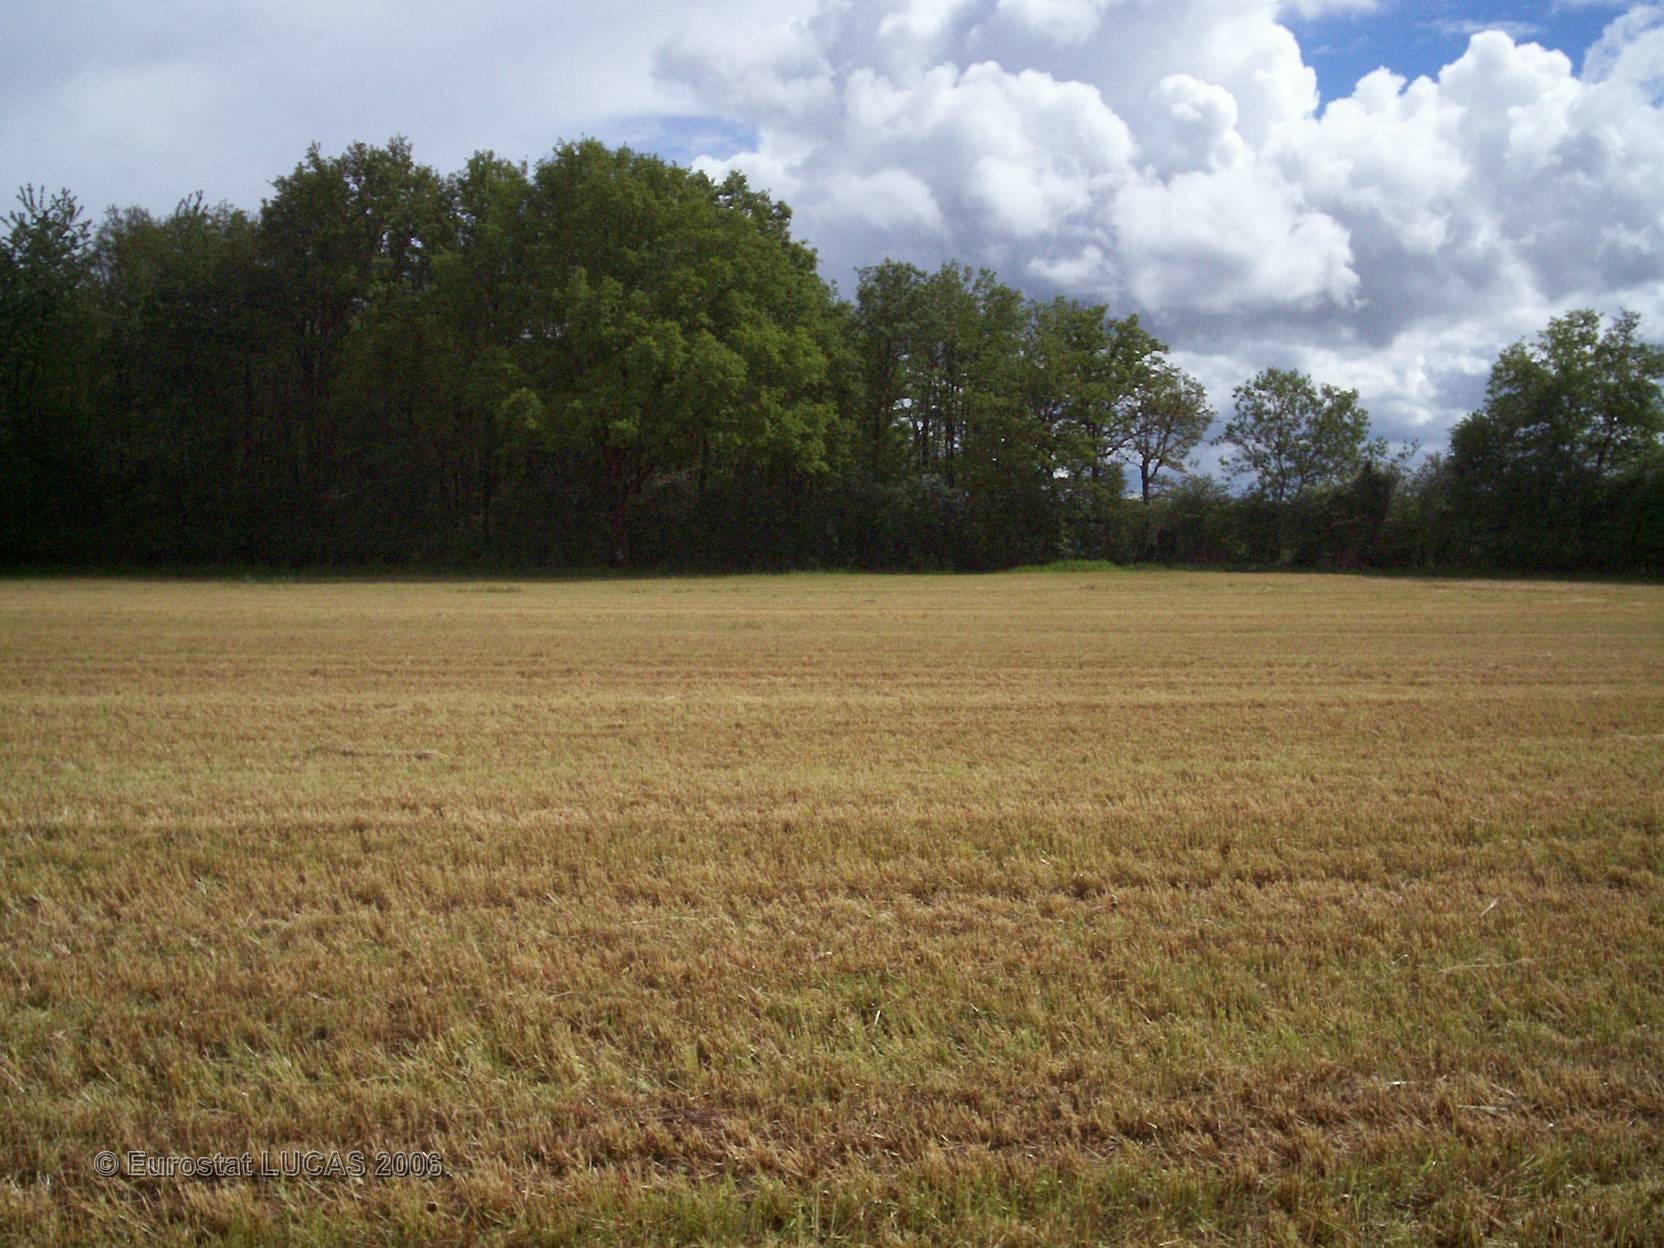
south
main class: Grassland
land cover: Grassland without tree/shrub cover
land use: Agriculture (excluding fallow land and kitchen gardens)
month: May
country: FR
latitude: 46.6173
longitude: -0.2756
